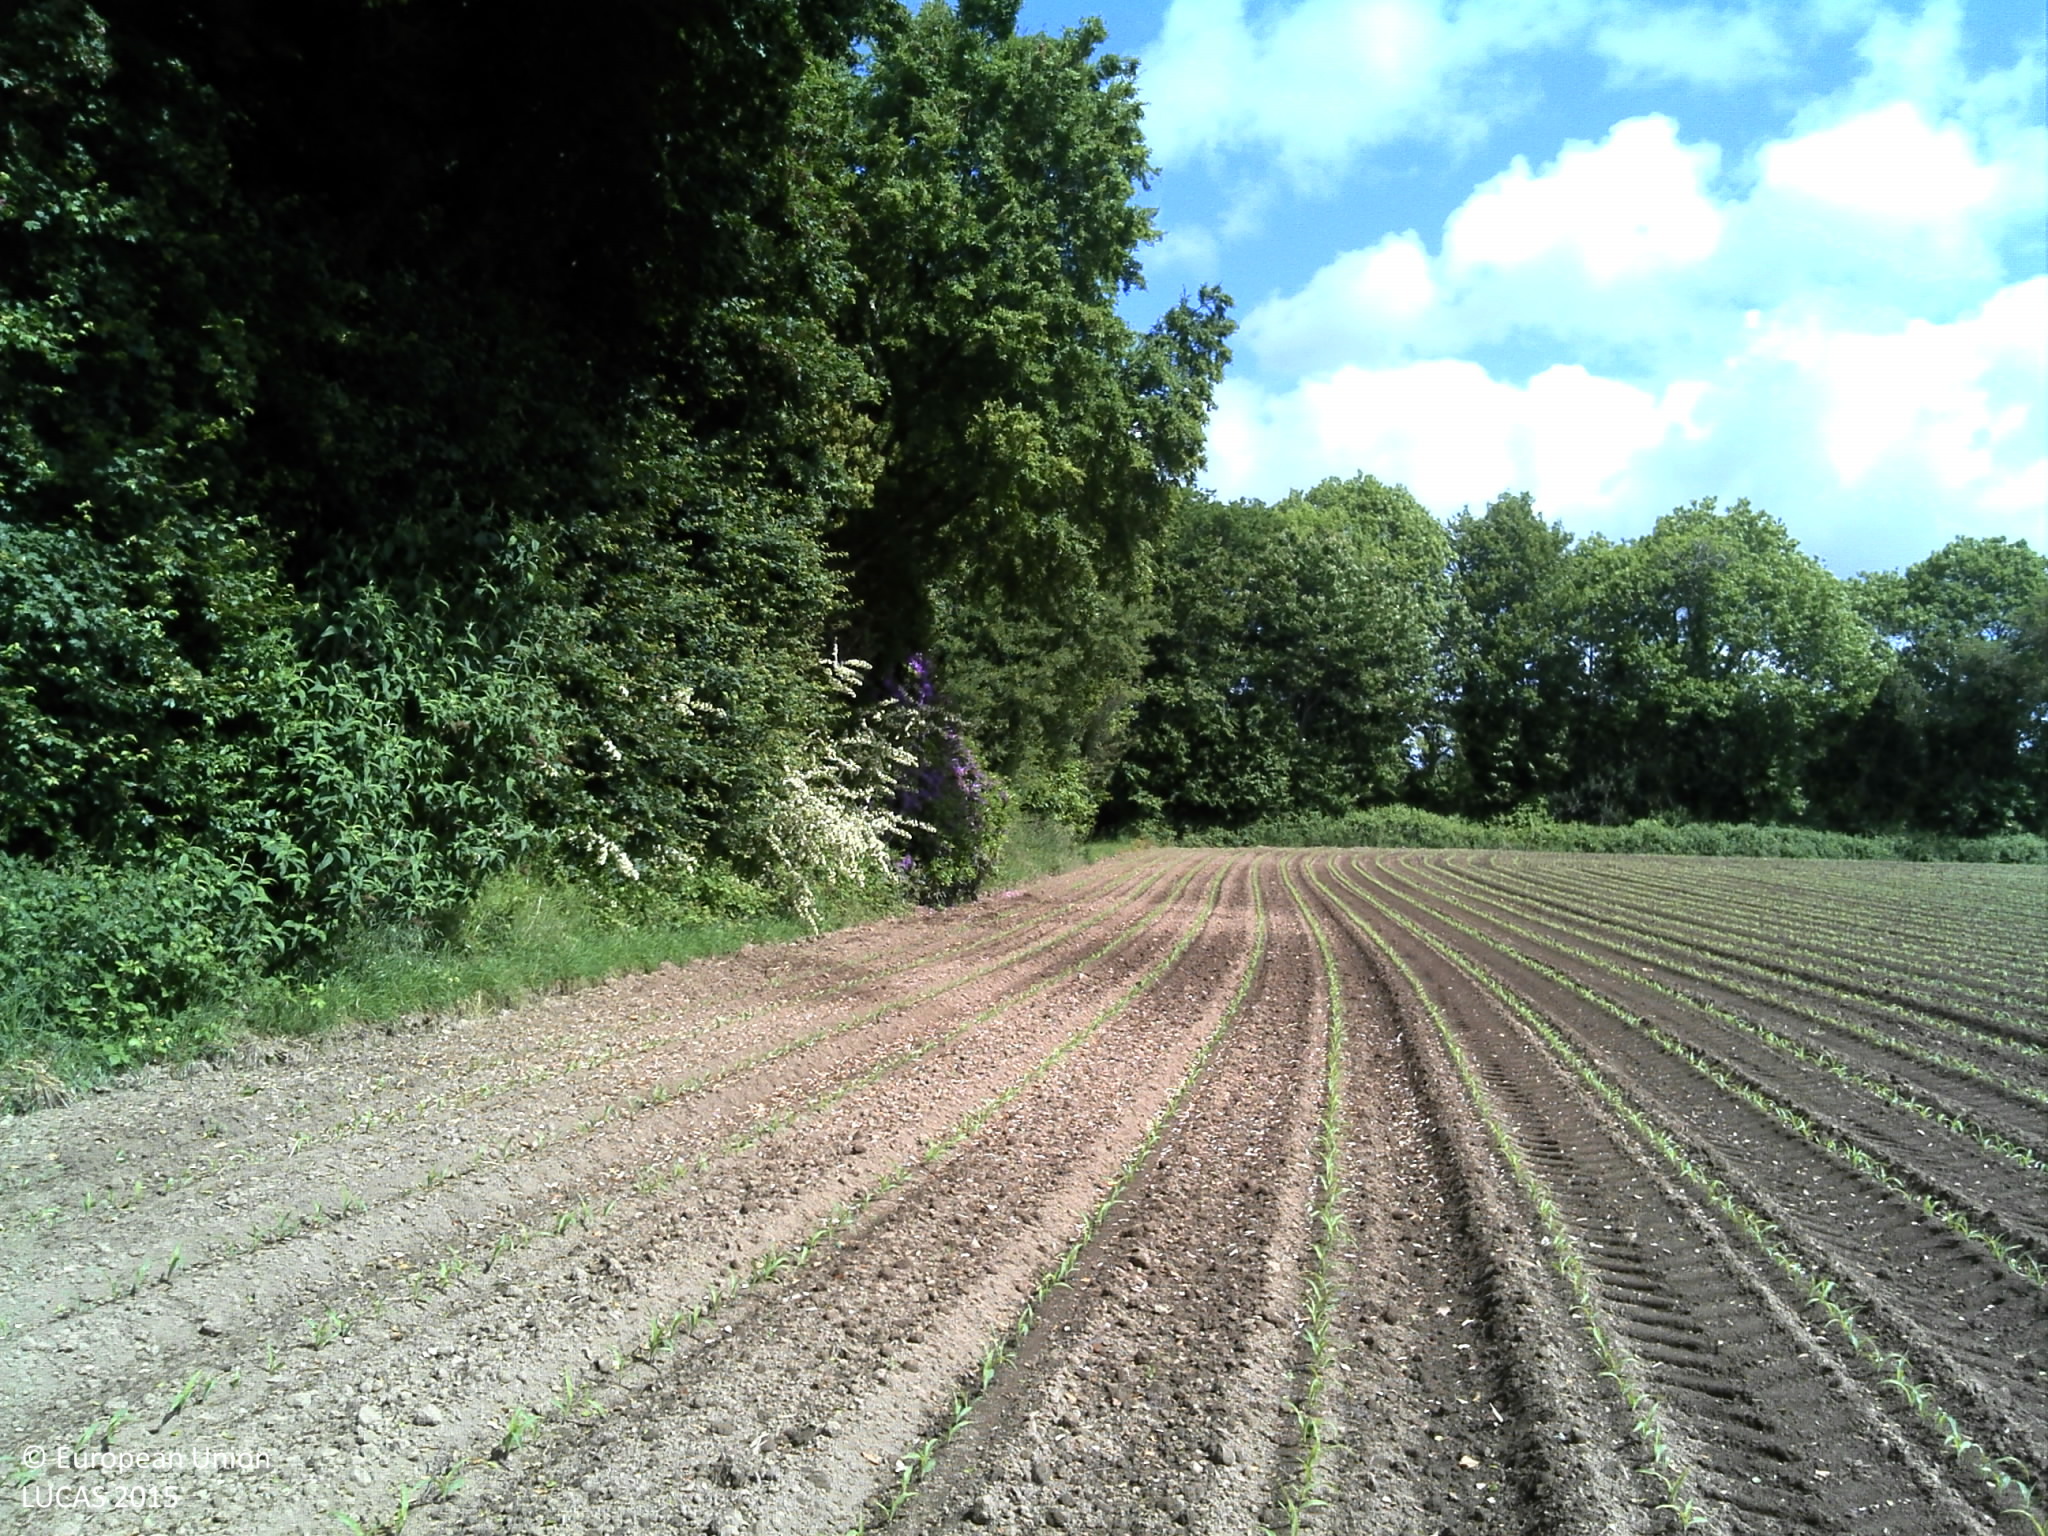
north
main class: Cropland
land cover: Maize
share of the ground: 10 - 25 %
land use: Agriculture (excluding fallow land and kitchen gardens)
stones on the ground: < 10 %
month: June
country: FR
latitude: 47.9145
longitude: -3.5240
